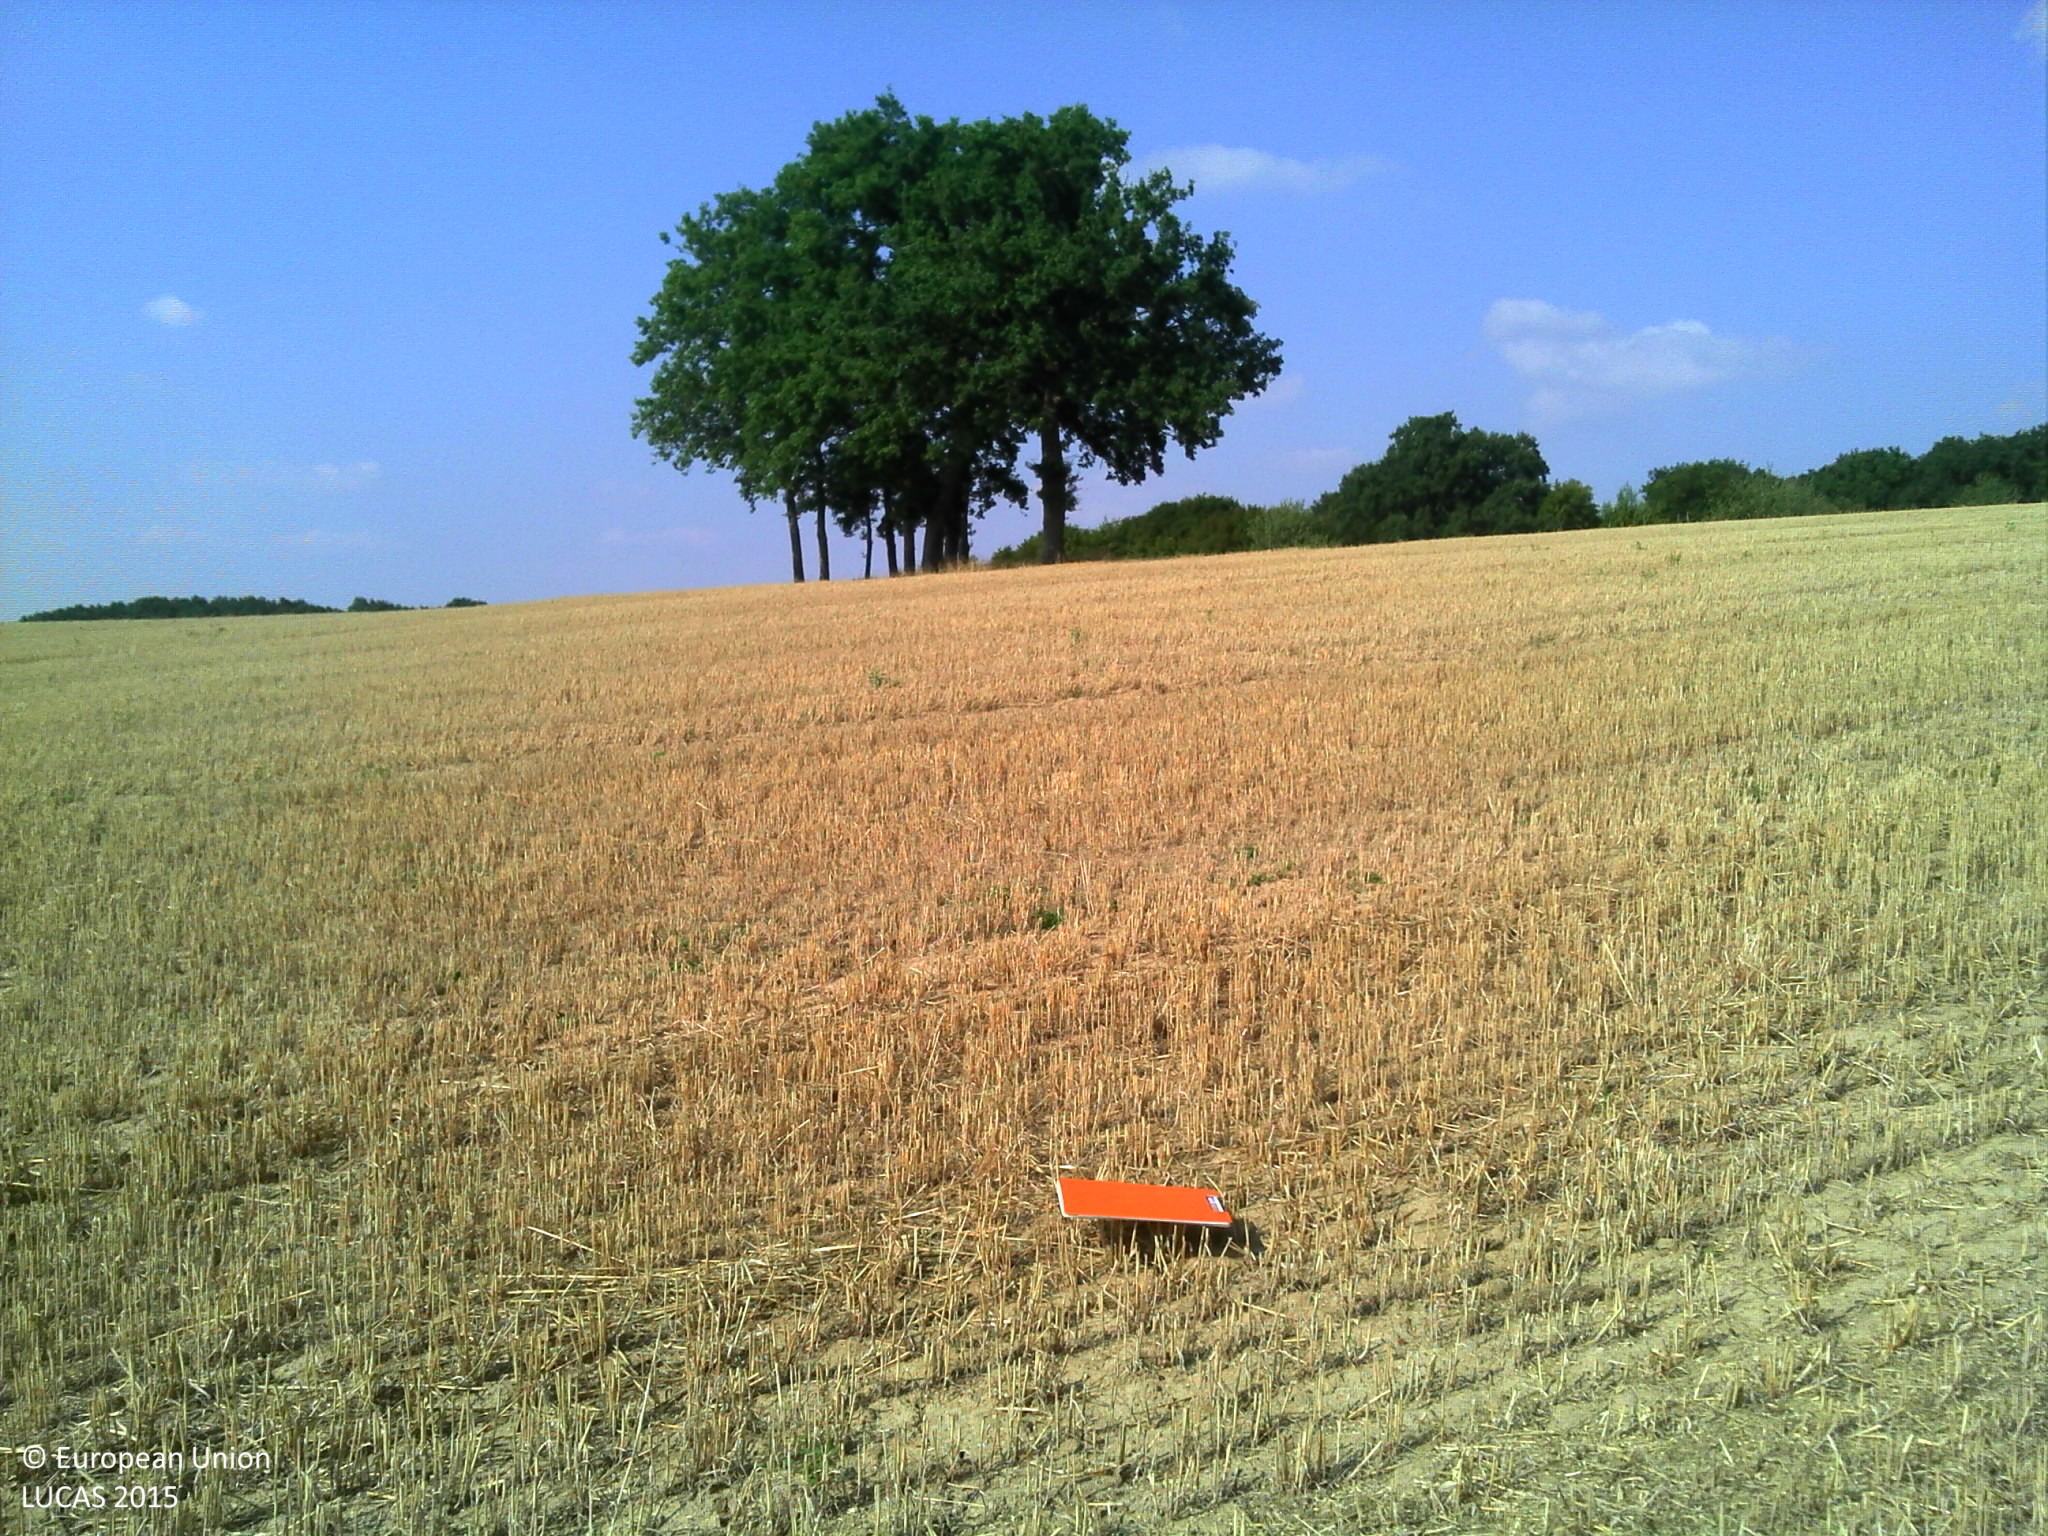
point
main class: Cropland
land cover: Common wheat
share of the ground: > 75 %
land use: Agriculture (excluding fallow land and kitchen gardens)
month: August
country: FR
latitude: 46.3952
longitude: 3.6139
